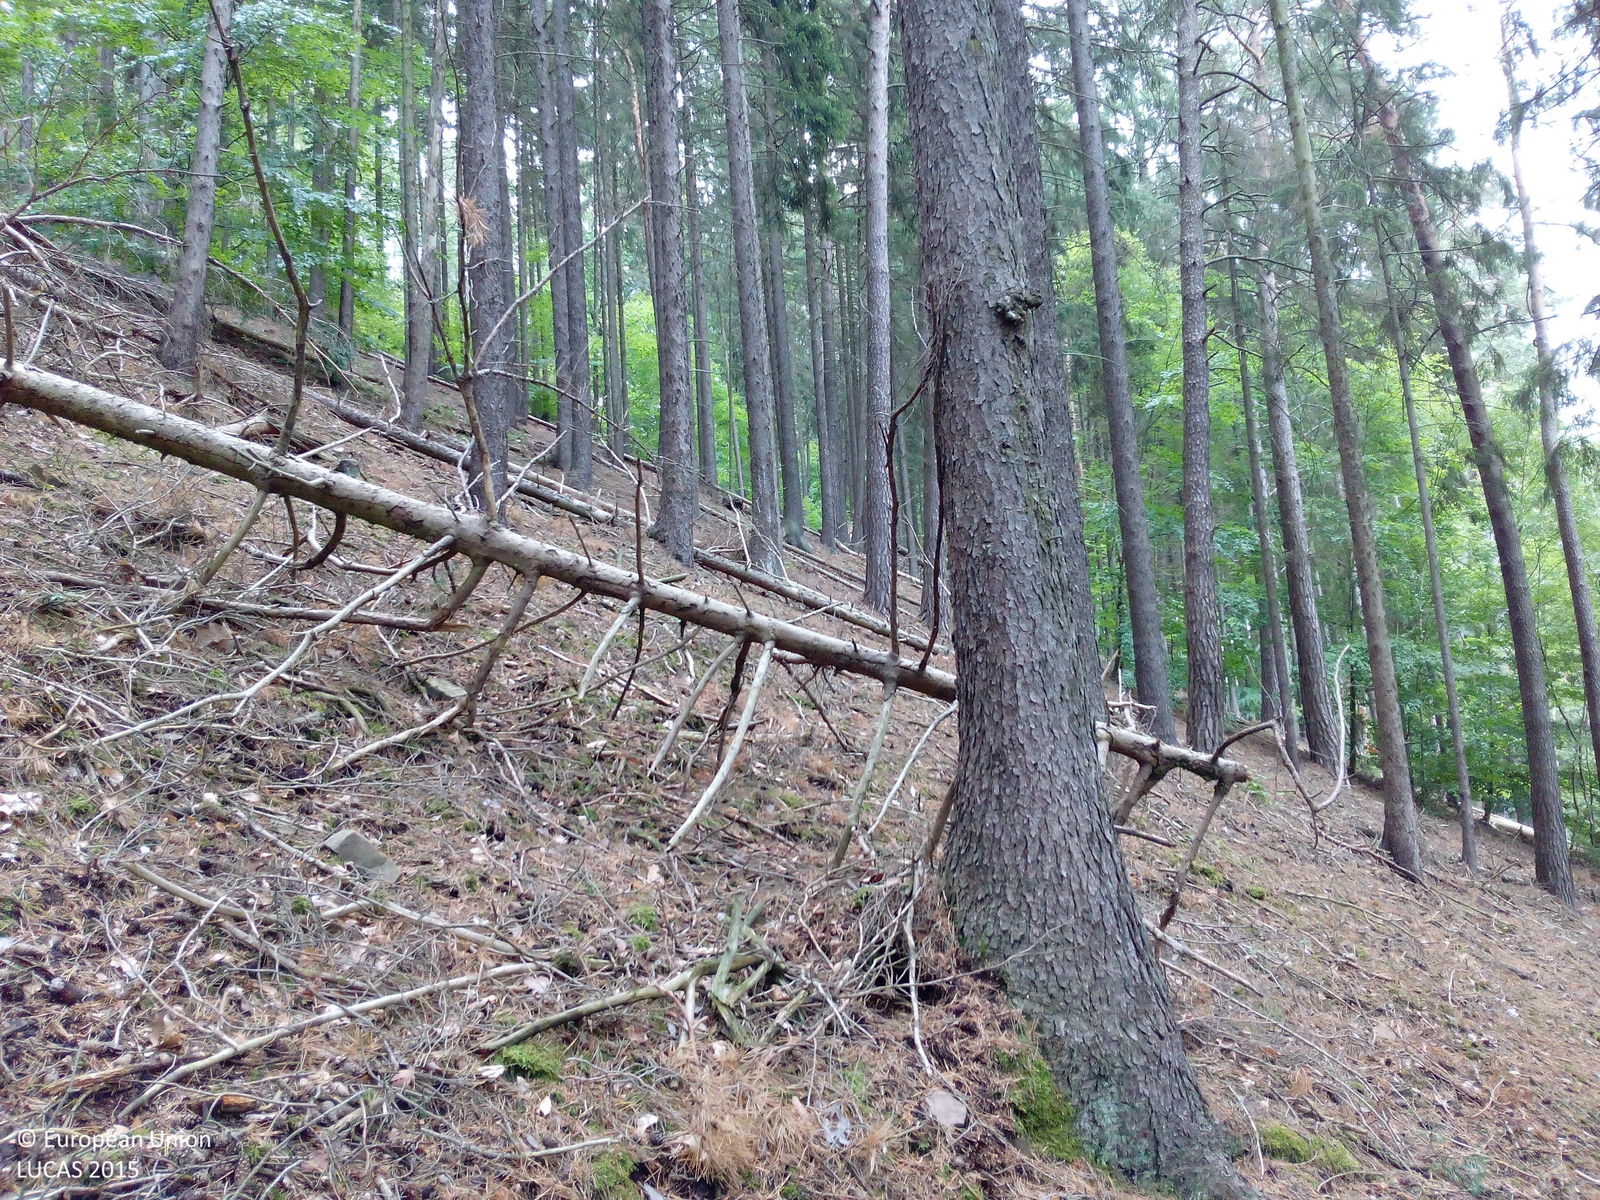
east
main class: Woodland
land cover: Pine dominated coniferous woodland
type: hemiboreal forest and nemoral coniferous forest and mixed broadleaved-coniferous forest
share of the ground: > 75 %
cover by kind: coniferous forest trees 100 %
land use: Forestry
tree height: > 5 m
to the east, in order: Pine dominated coniferous woodland; Spruce dominated coniferous woodland; Spruce dominated mixed woodland; Tracks; Spruce dominated mixed woodland; Broadleaved woodland
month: July
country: DE
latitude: 51.6225
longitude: 9.9567
